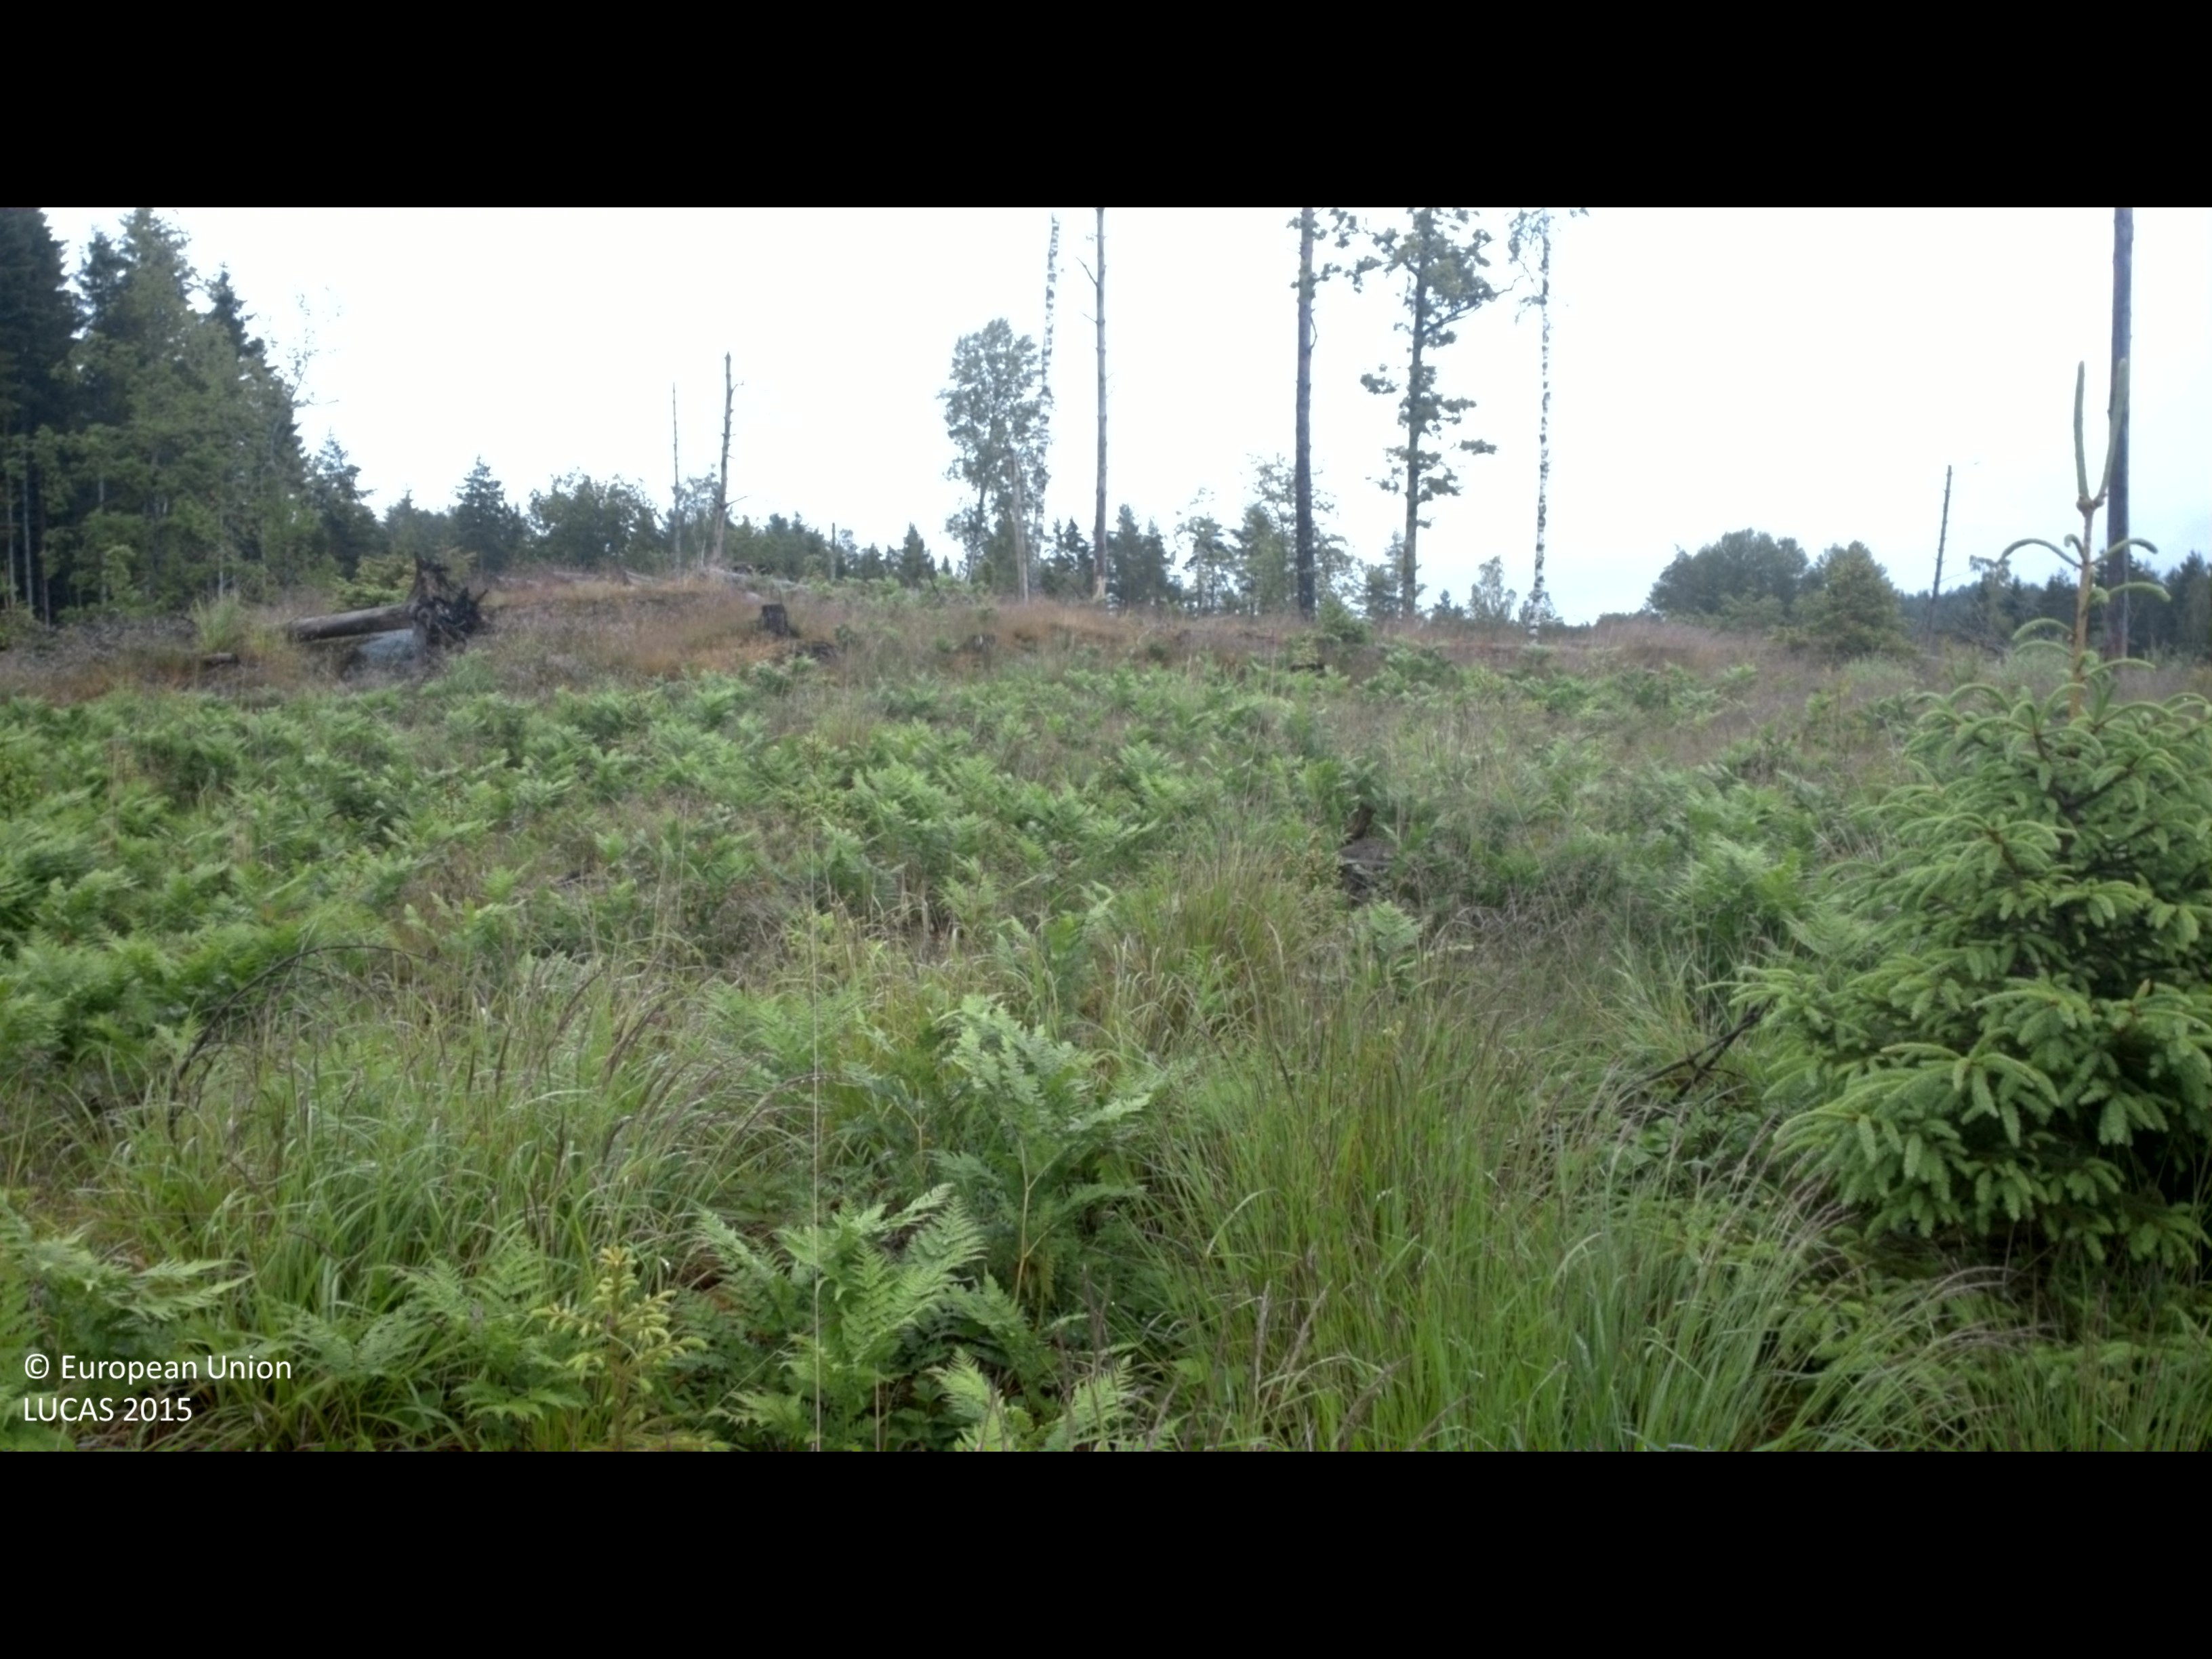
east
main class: Woodland
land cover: Spruce dominated coniferous woodland
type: boreal forest
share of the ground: 10 - 25 %
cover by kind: herbaceous plants 70 %, coniferous forest trees 15 %, shrubs 15 %
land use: Forestry
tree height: < 5 m
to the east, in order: Spruce dominated coniferous woodland; Other mixed woodland; Shrubland with sparse tree cover; Spontaneously vegetated surfaces; Shrubland with sparse tree cover; Pine dominated coniferous woodland; Rocks and stones; Spruce dominated coniferous woodland
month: June
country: SE
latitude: 58.0592
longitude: 16.1824
